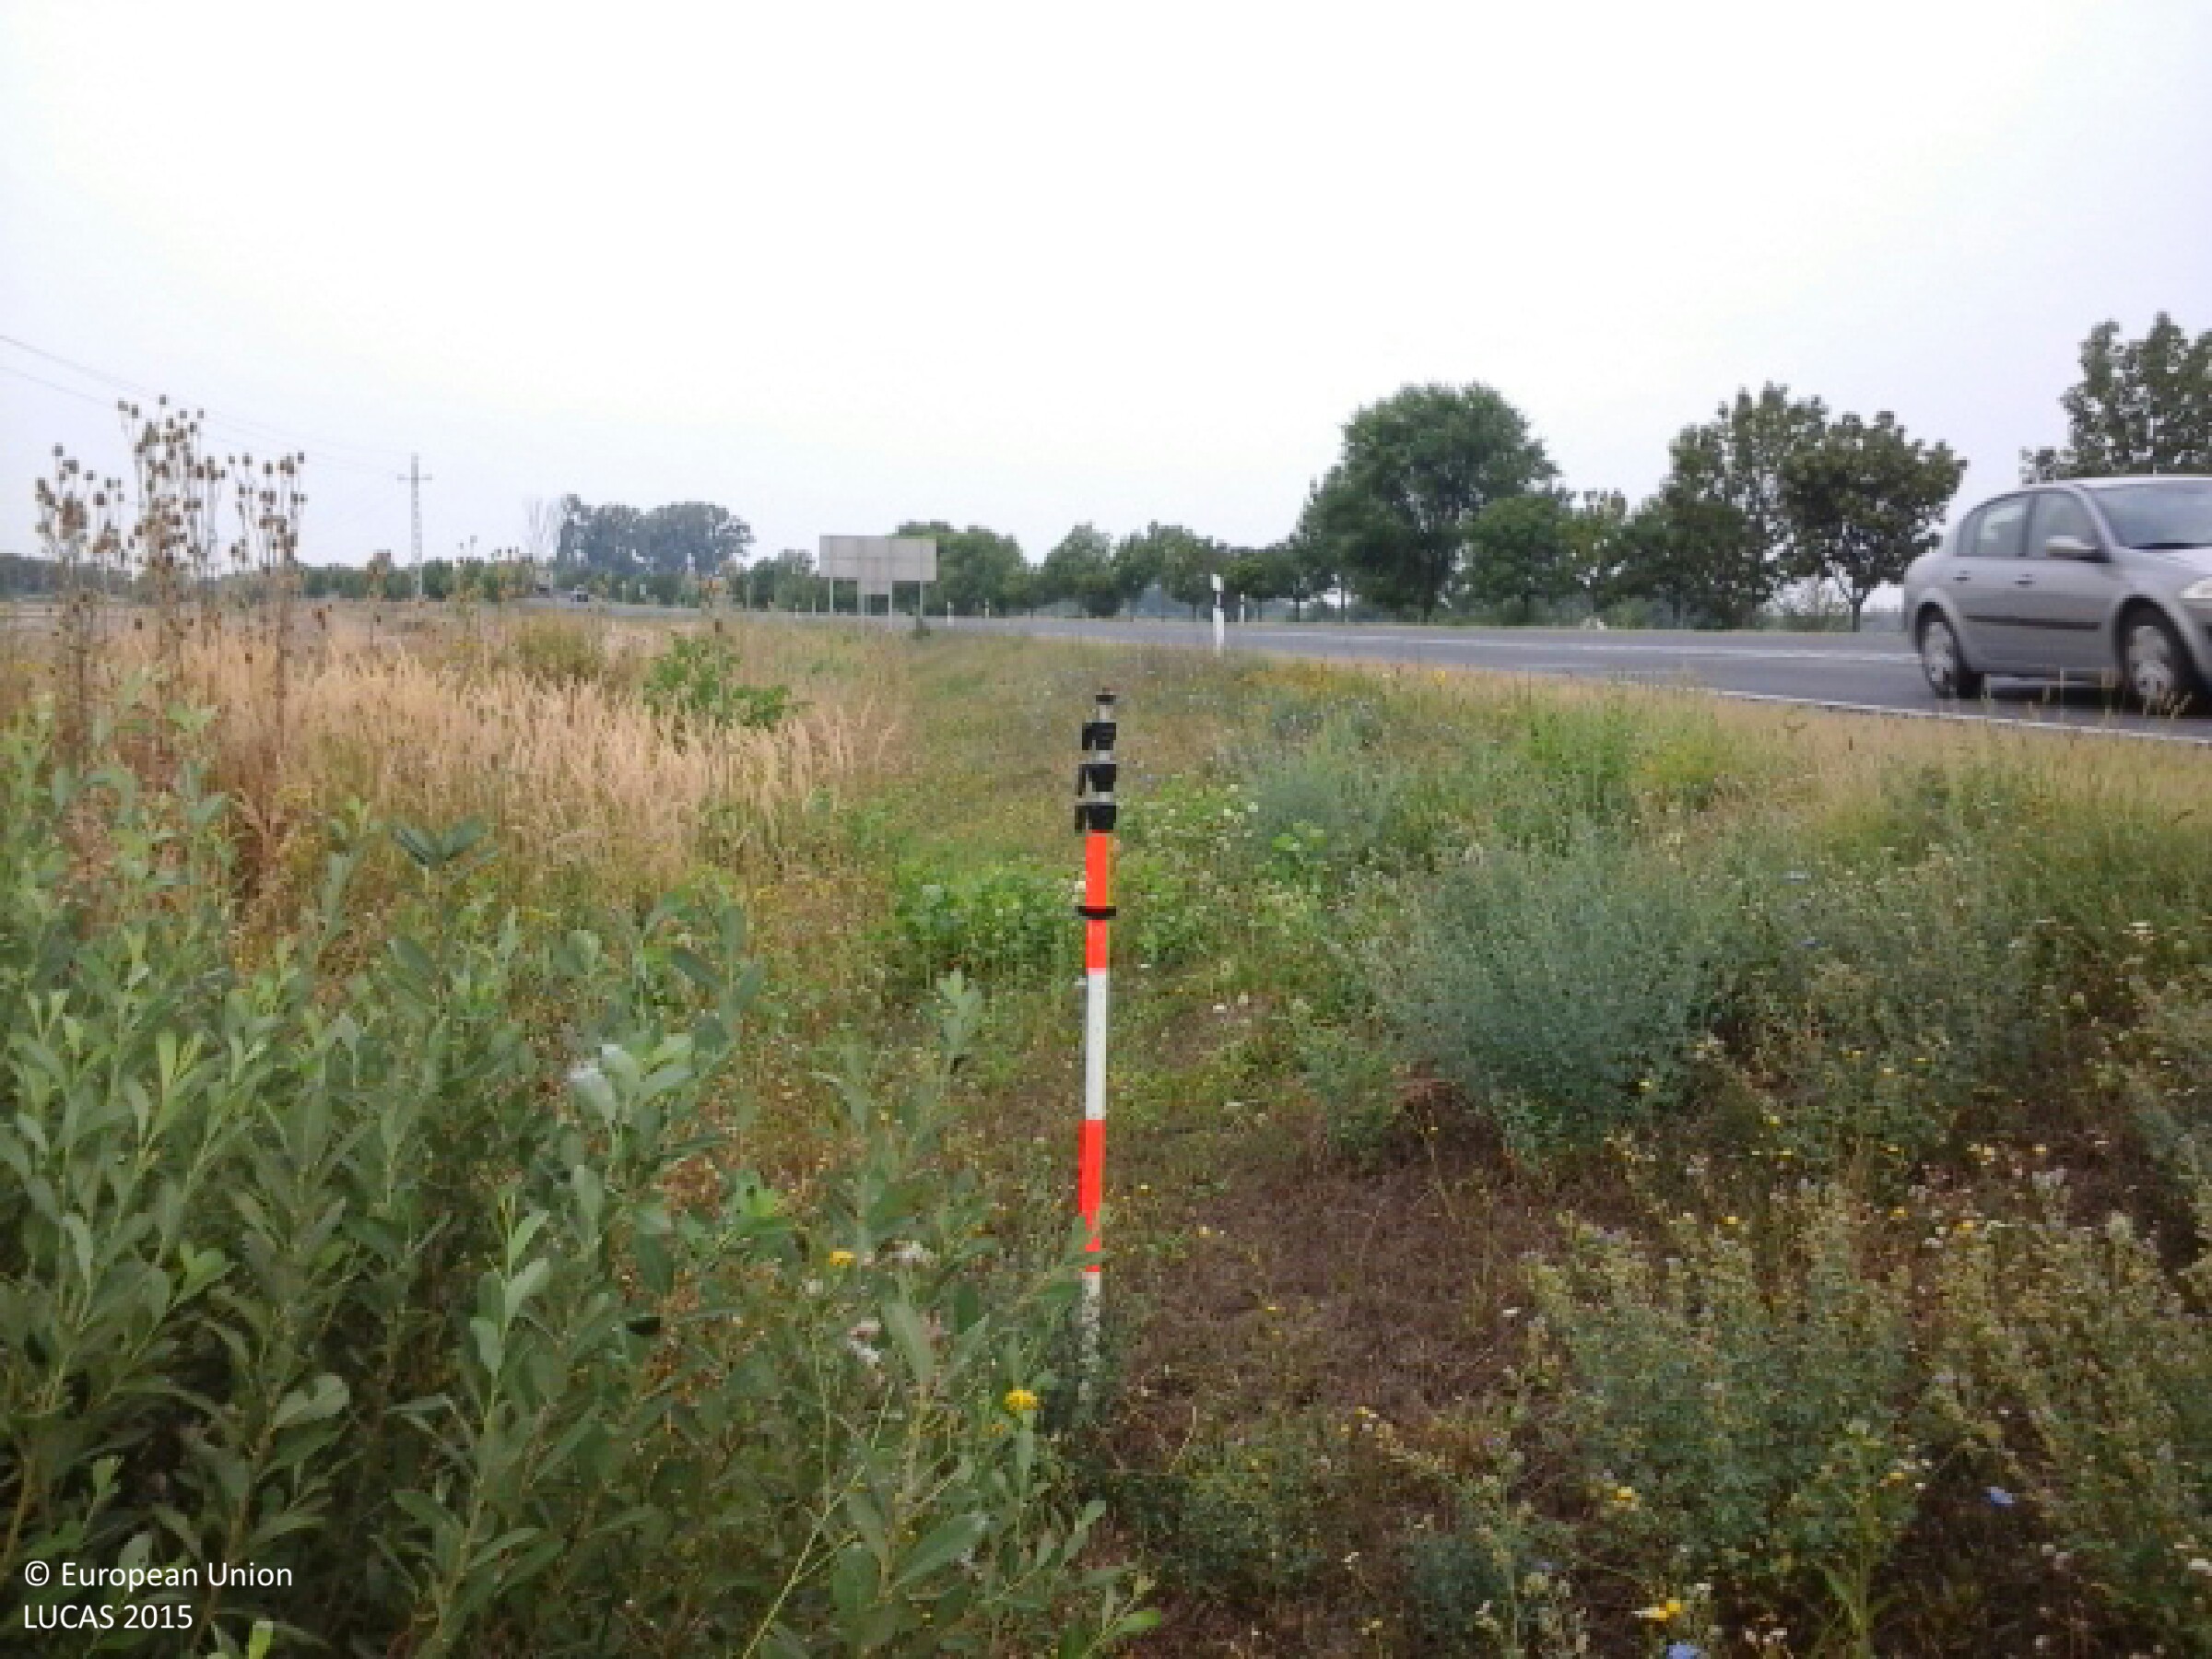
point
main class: Grassland
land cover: Spontaneously vegetated surfaces
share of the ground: > 75 %
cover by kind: herbaceous plants 100 %
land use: Semi-natural and natural areas not in use
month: August
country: HU
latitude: 47.1421
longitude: 21.7135
